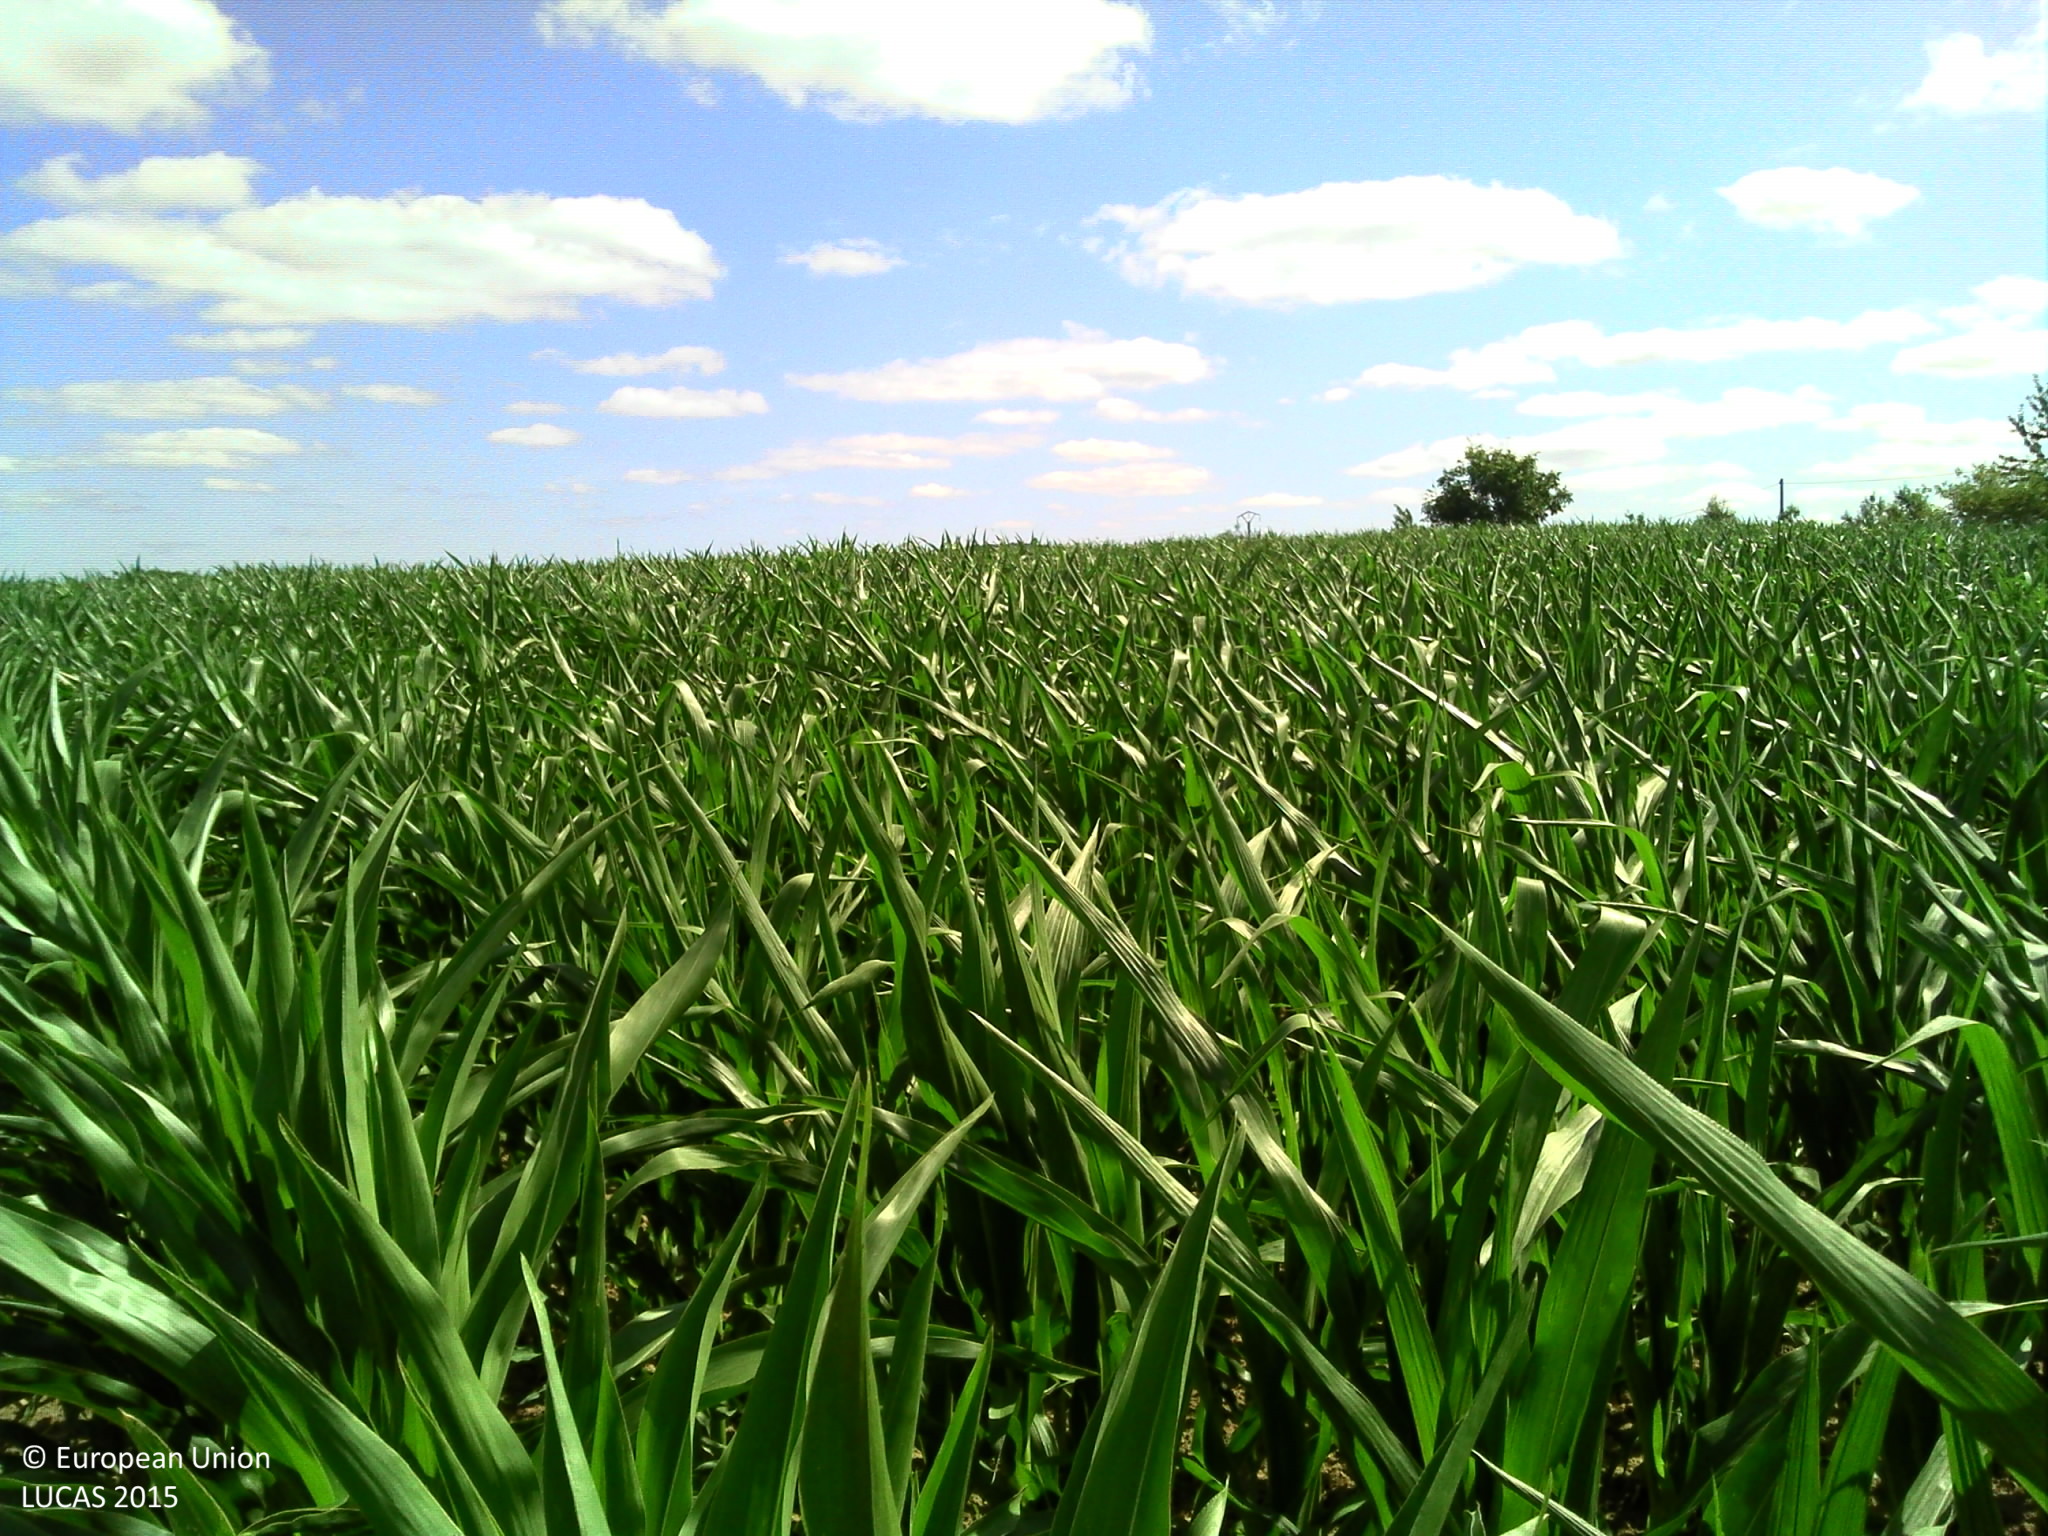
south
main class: Cropland
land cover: Maize
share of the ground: > 75 %
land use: Agriculture (excluding fallow land and kitchen gardens)
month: July
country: FR
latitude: 46.3193
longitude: 1.7187
